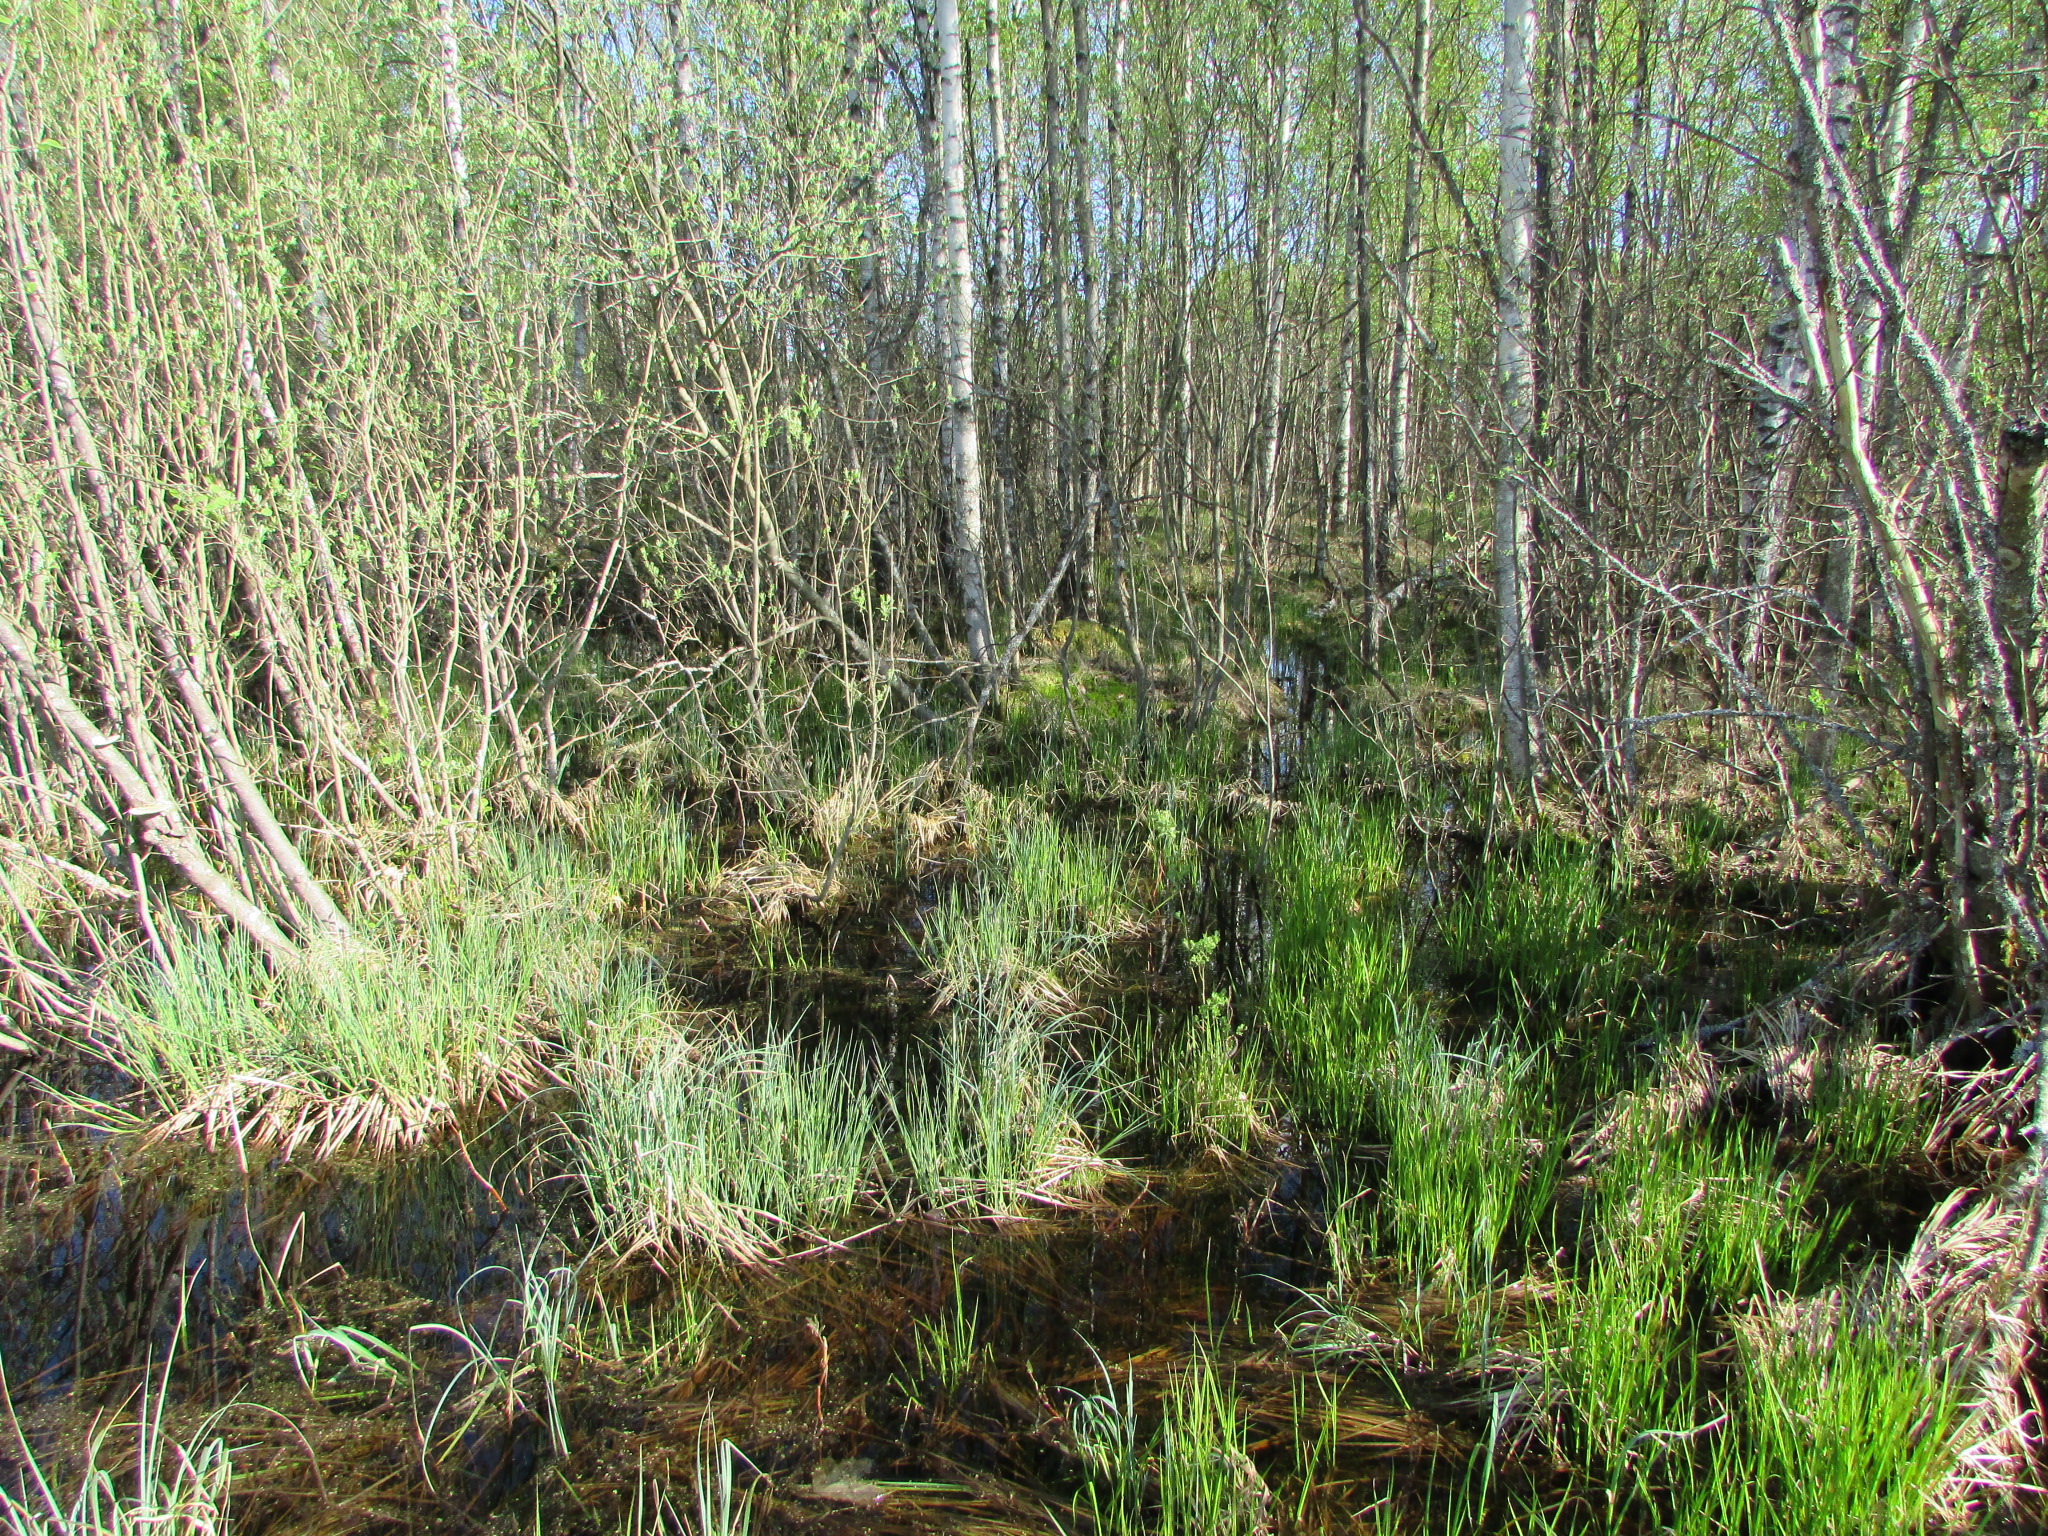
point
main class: Woodland
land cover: Broadleaved woodland
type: non-riverine alder, birch or aspen forest
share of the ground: > 75 %
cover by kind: broadleaved forest trees 100 %
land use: Semi-natural and natural areas not in use
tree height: > 5 m
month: May
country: LV
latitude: 56.1270
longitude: 27.1418
